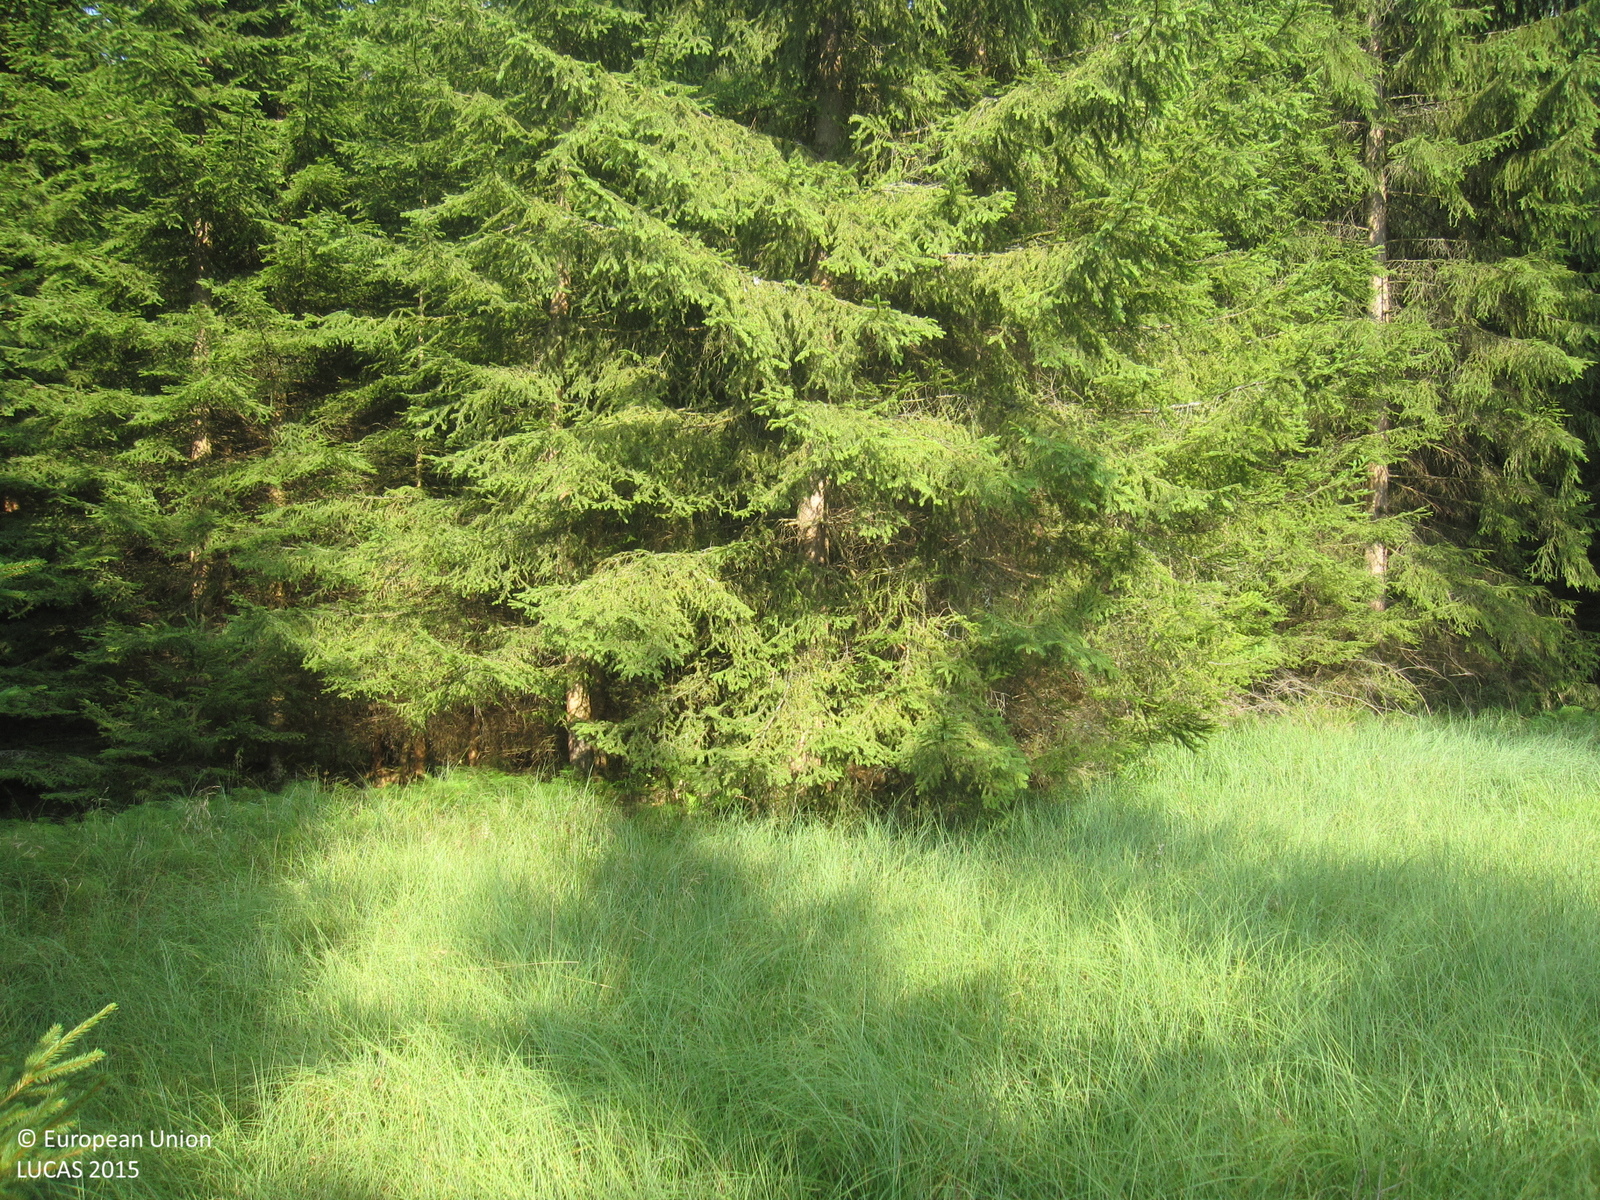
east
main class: Woodland
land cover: Spruce dominated coniferous woodland
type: hemiboreal forest and nemoral coniferous forest and mixed broadleaved-coniferous forest
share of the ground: > 75 %
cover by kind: coniferous forest trees 95 %, unconsolidated bare surface 5 %
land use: Forestry
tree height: > 5 m
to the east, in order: Spruce dominated coniferous woodland; Tracks; Spruce dominated coniferous woodland
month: August
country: DE
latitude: 50.4257
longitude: 11.5339
